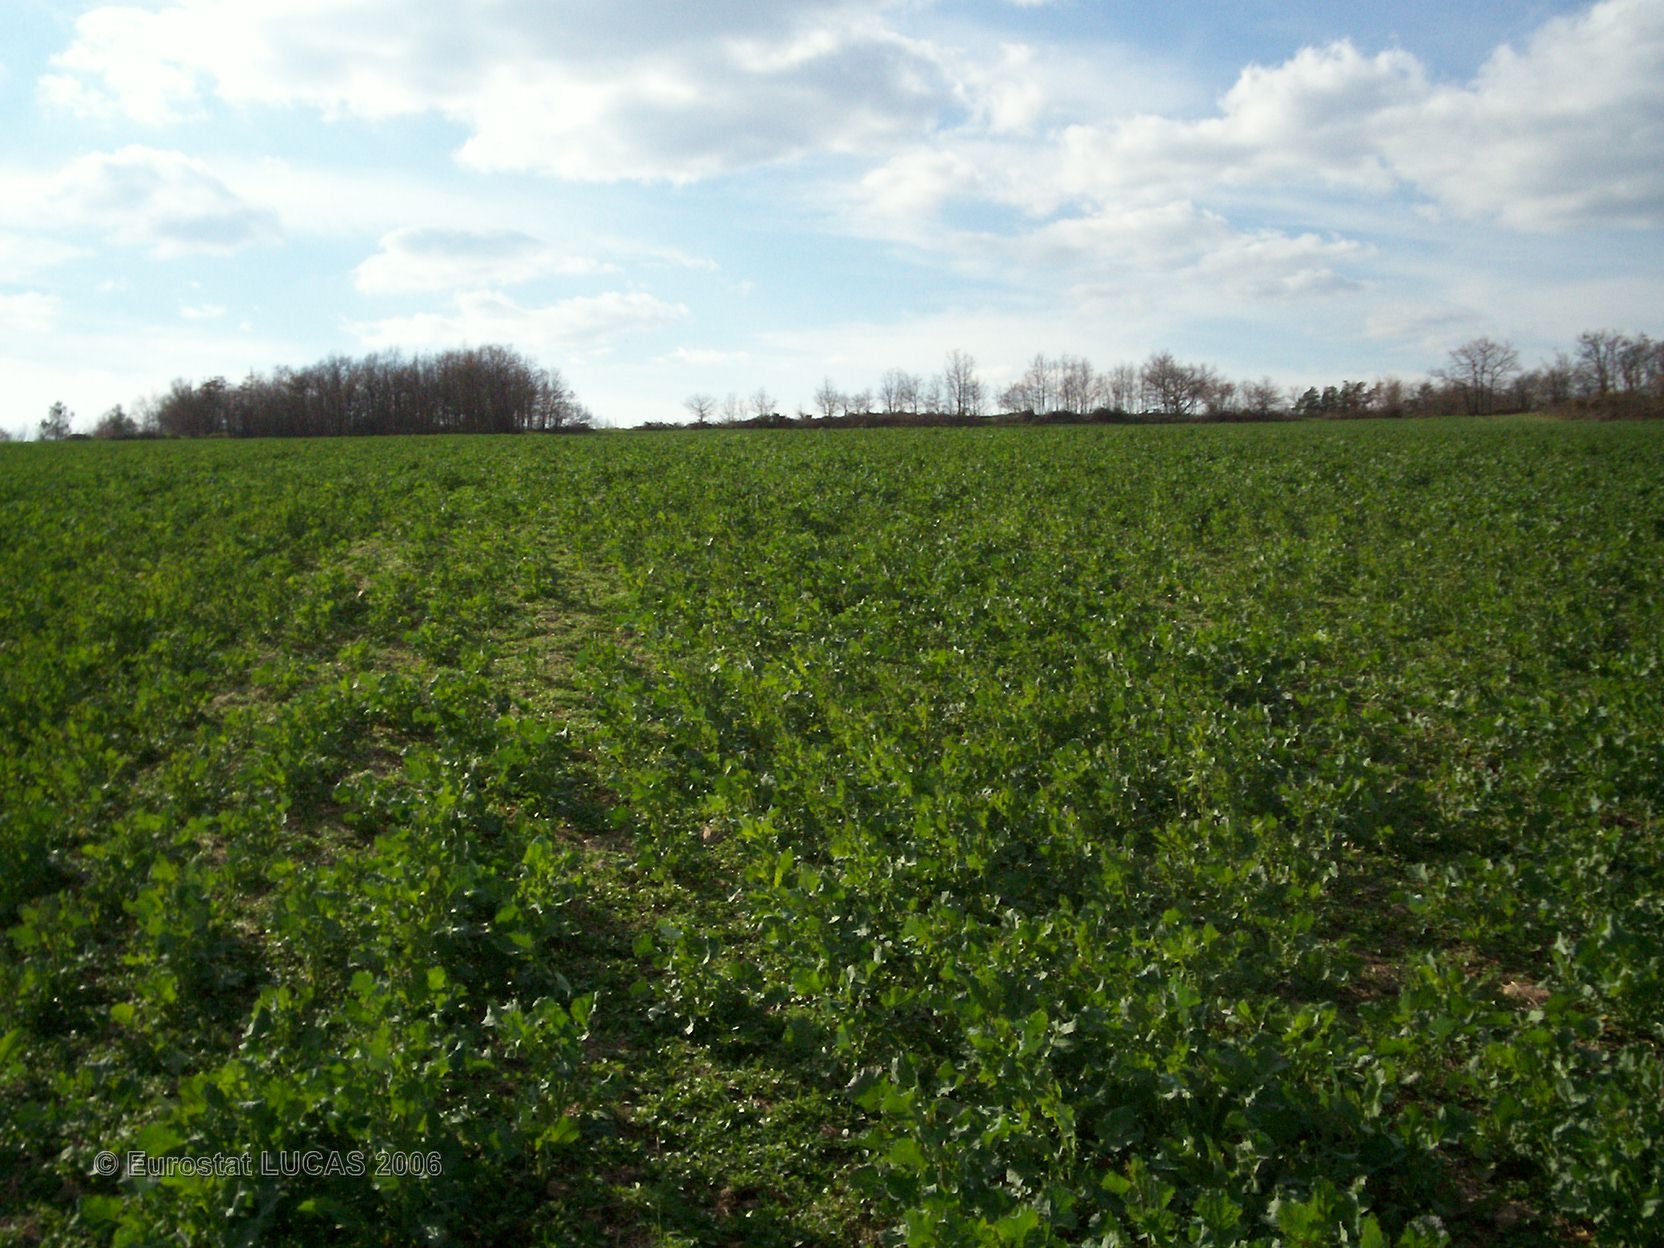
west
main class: Cropland
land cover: Rape and turnip rape
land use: Agriculture (excluding fallow land and kitchen gardens)
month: April
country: FR
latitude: 45.3442
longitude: 3.2759
